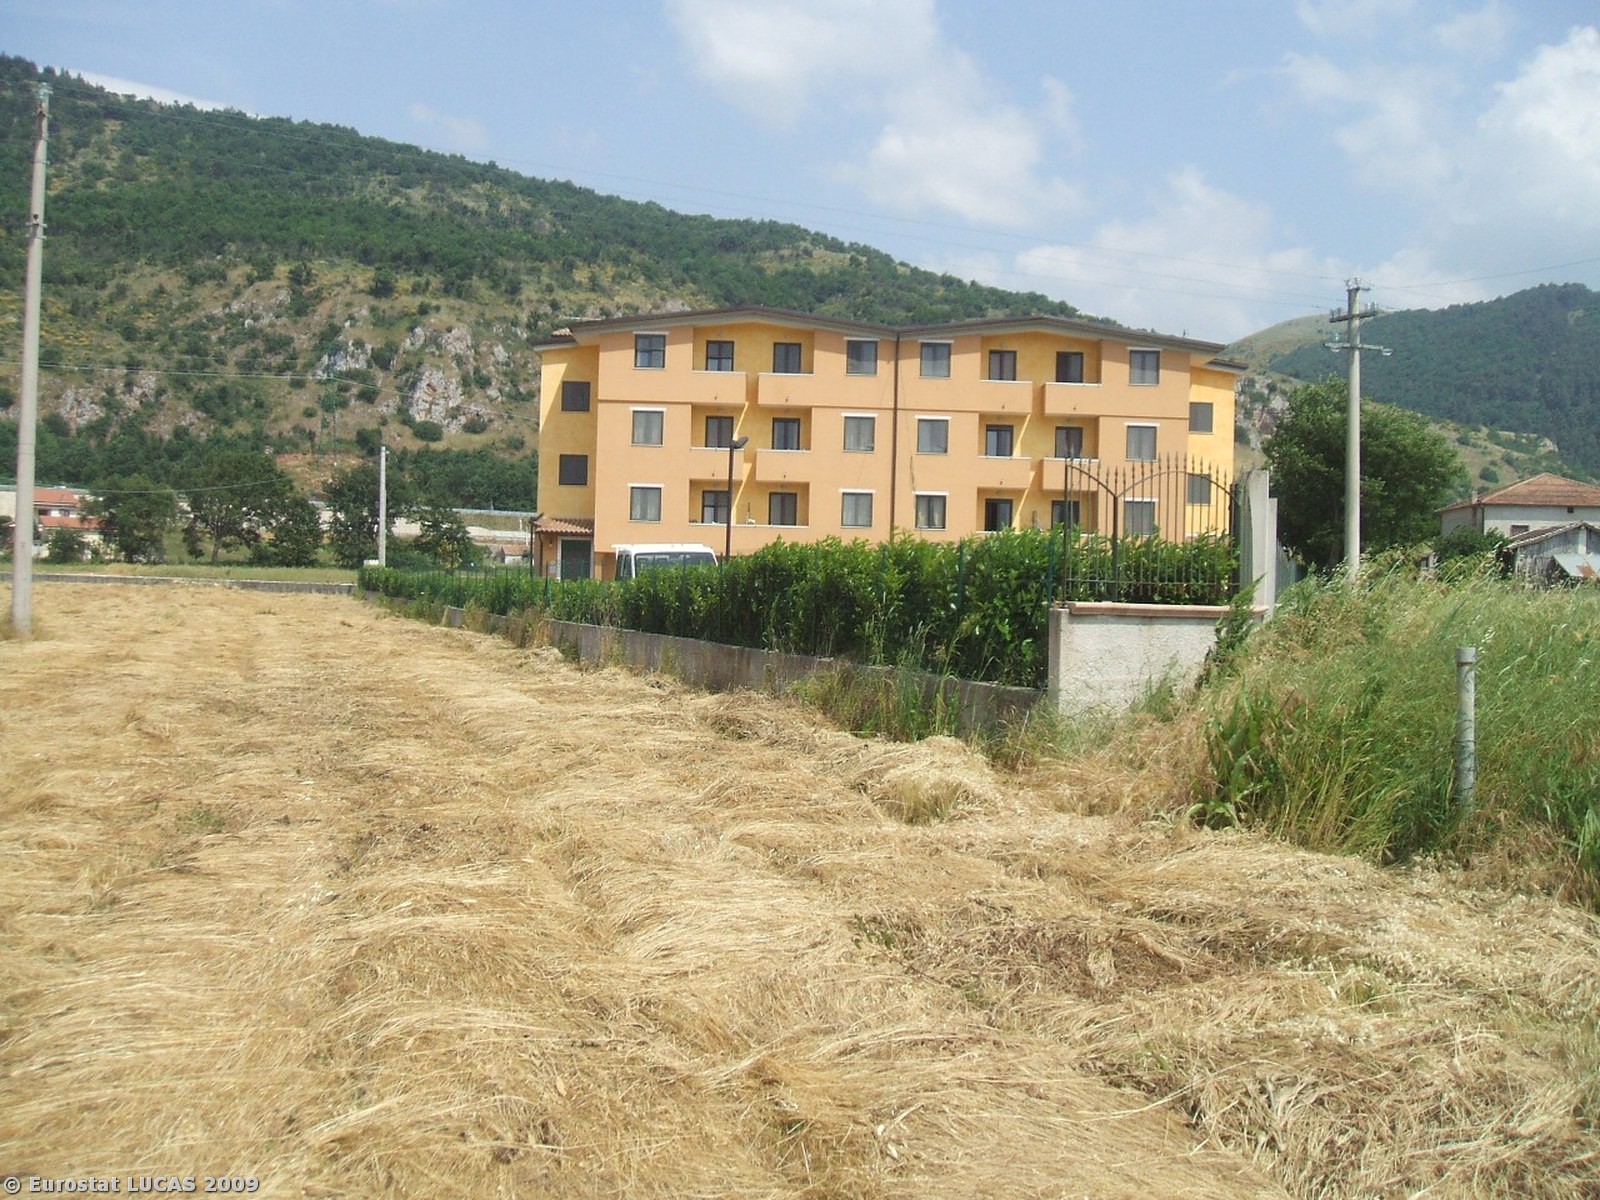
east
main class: Cropland
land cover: Other leguminous and mixtures for fodder
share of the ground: > 75 %
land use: Agriculture (excluding fallow land and kitchen gardens)
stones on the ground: < 10 %
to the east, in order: Other leguminous and mixtures for fodder; Electric lines; Other leguminous and mixtures for fodder; Artificial constructions in urban areas; Electric lines; Grass margins; Ditches and canals; Paved roads, cycling and walking lanes; Ditches and canals; Grassland without tree/shrub cover; Other leguminous and mixtures for fodder
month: May
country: IT
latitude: 40.4739
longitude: 15.5329
